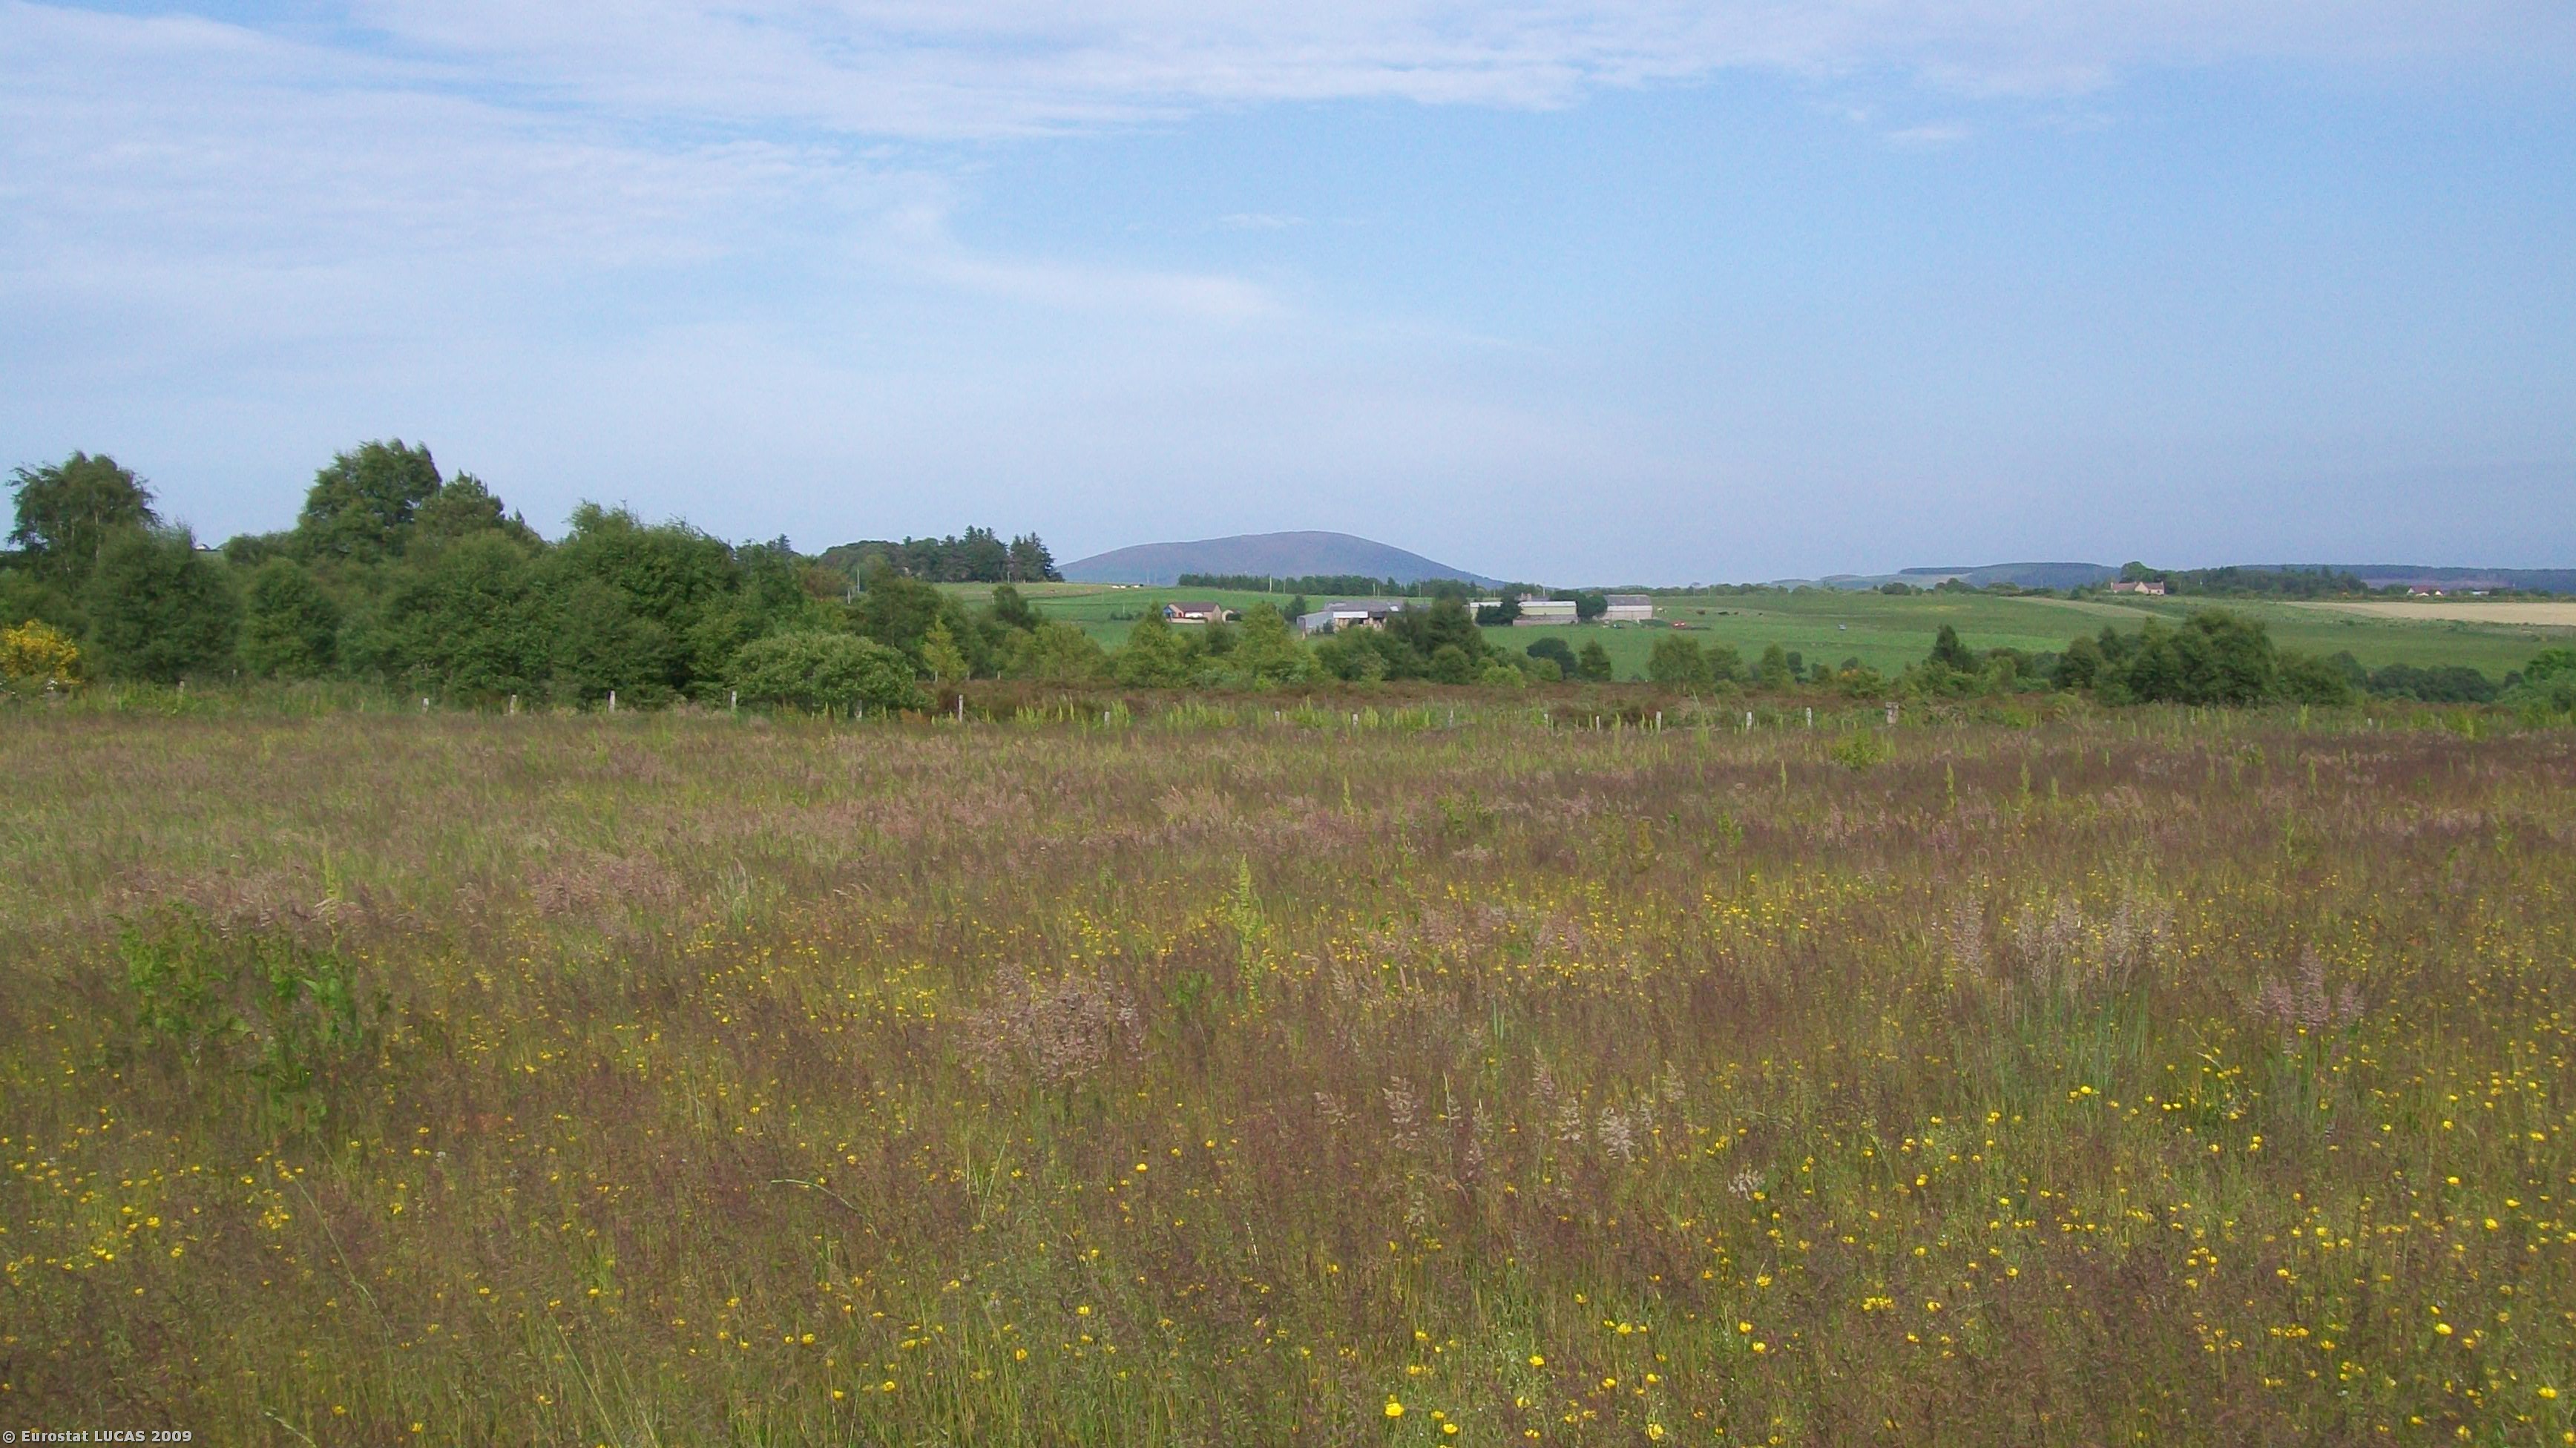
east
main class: Grassland
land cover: Grassland without tree/shrub cover
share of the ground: > 75 %
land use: Fallow land
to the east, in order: Grassland without tree/shrub cover; Fences; Ditches and canals; Grassland without tree/shrub cover; Shrubland without tree cover; Broadleaved woodland; Shrubland with sparse tree cover; Broadleaved woodland; Fences; Grassland without tree/shrub cover
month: June
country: GB
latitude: 57.5744
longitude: -2.9180
